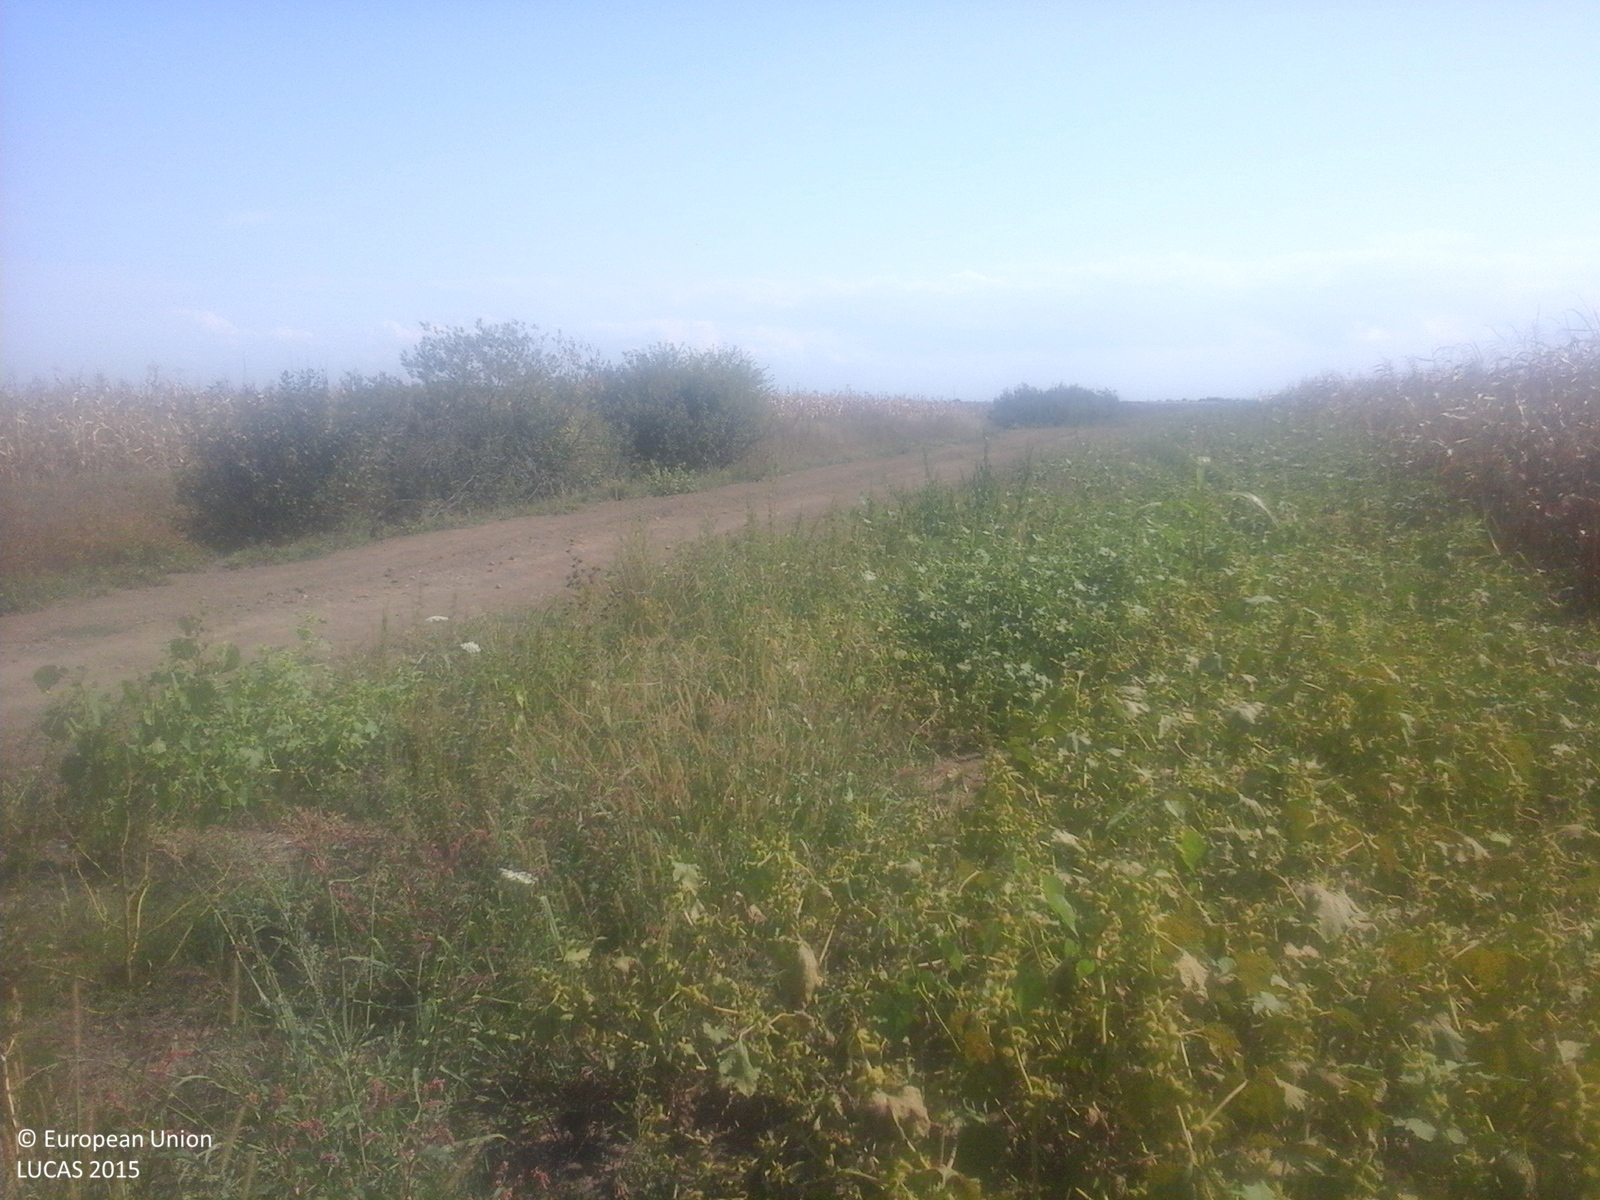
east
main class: Cropland
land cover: Maize
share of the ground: > 75 %
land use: Agriculture (excluding fallow land and kitchen gardens)
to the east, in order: Maize; Spontaneously vegetated surfaces; Maize; Sunflower
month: September
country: RO
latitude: 47.7330
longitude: 22.6073
